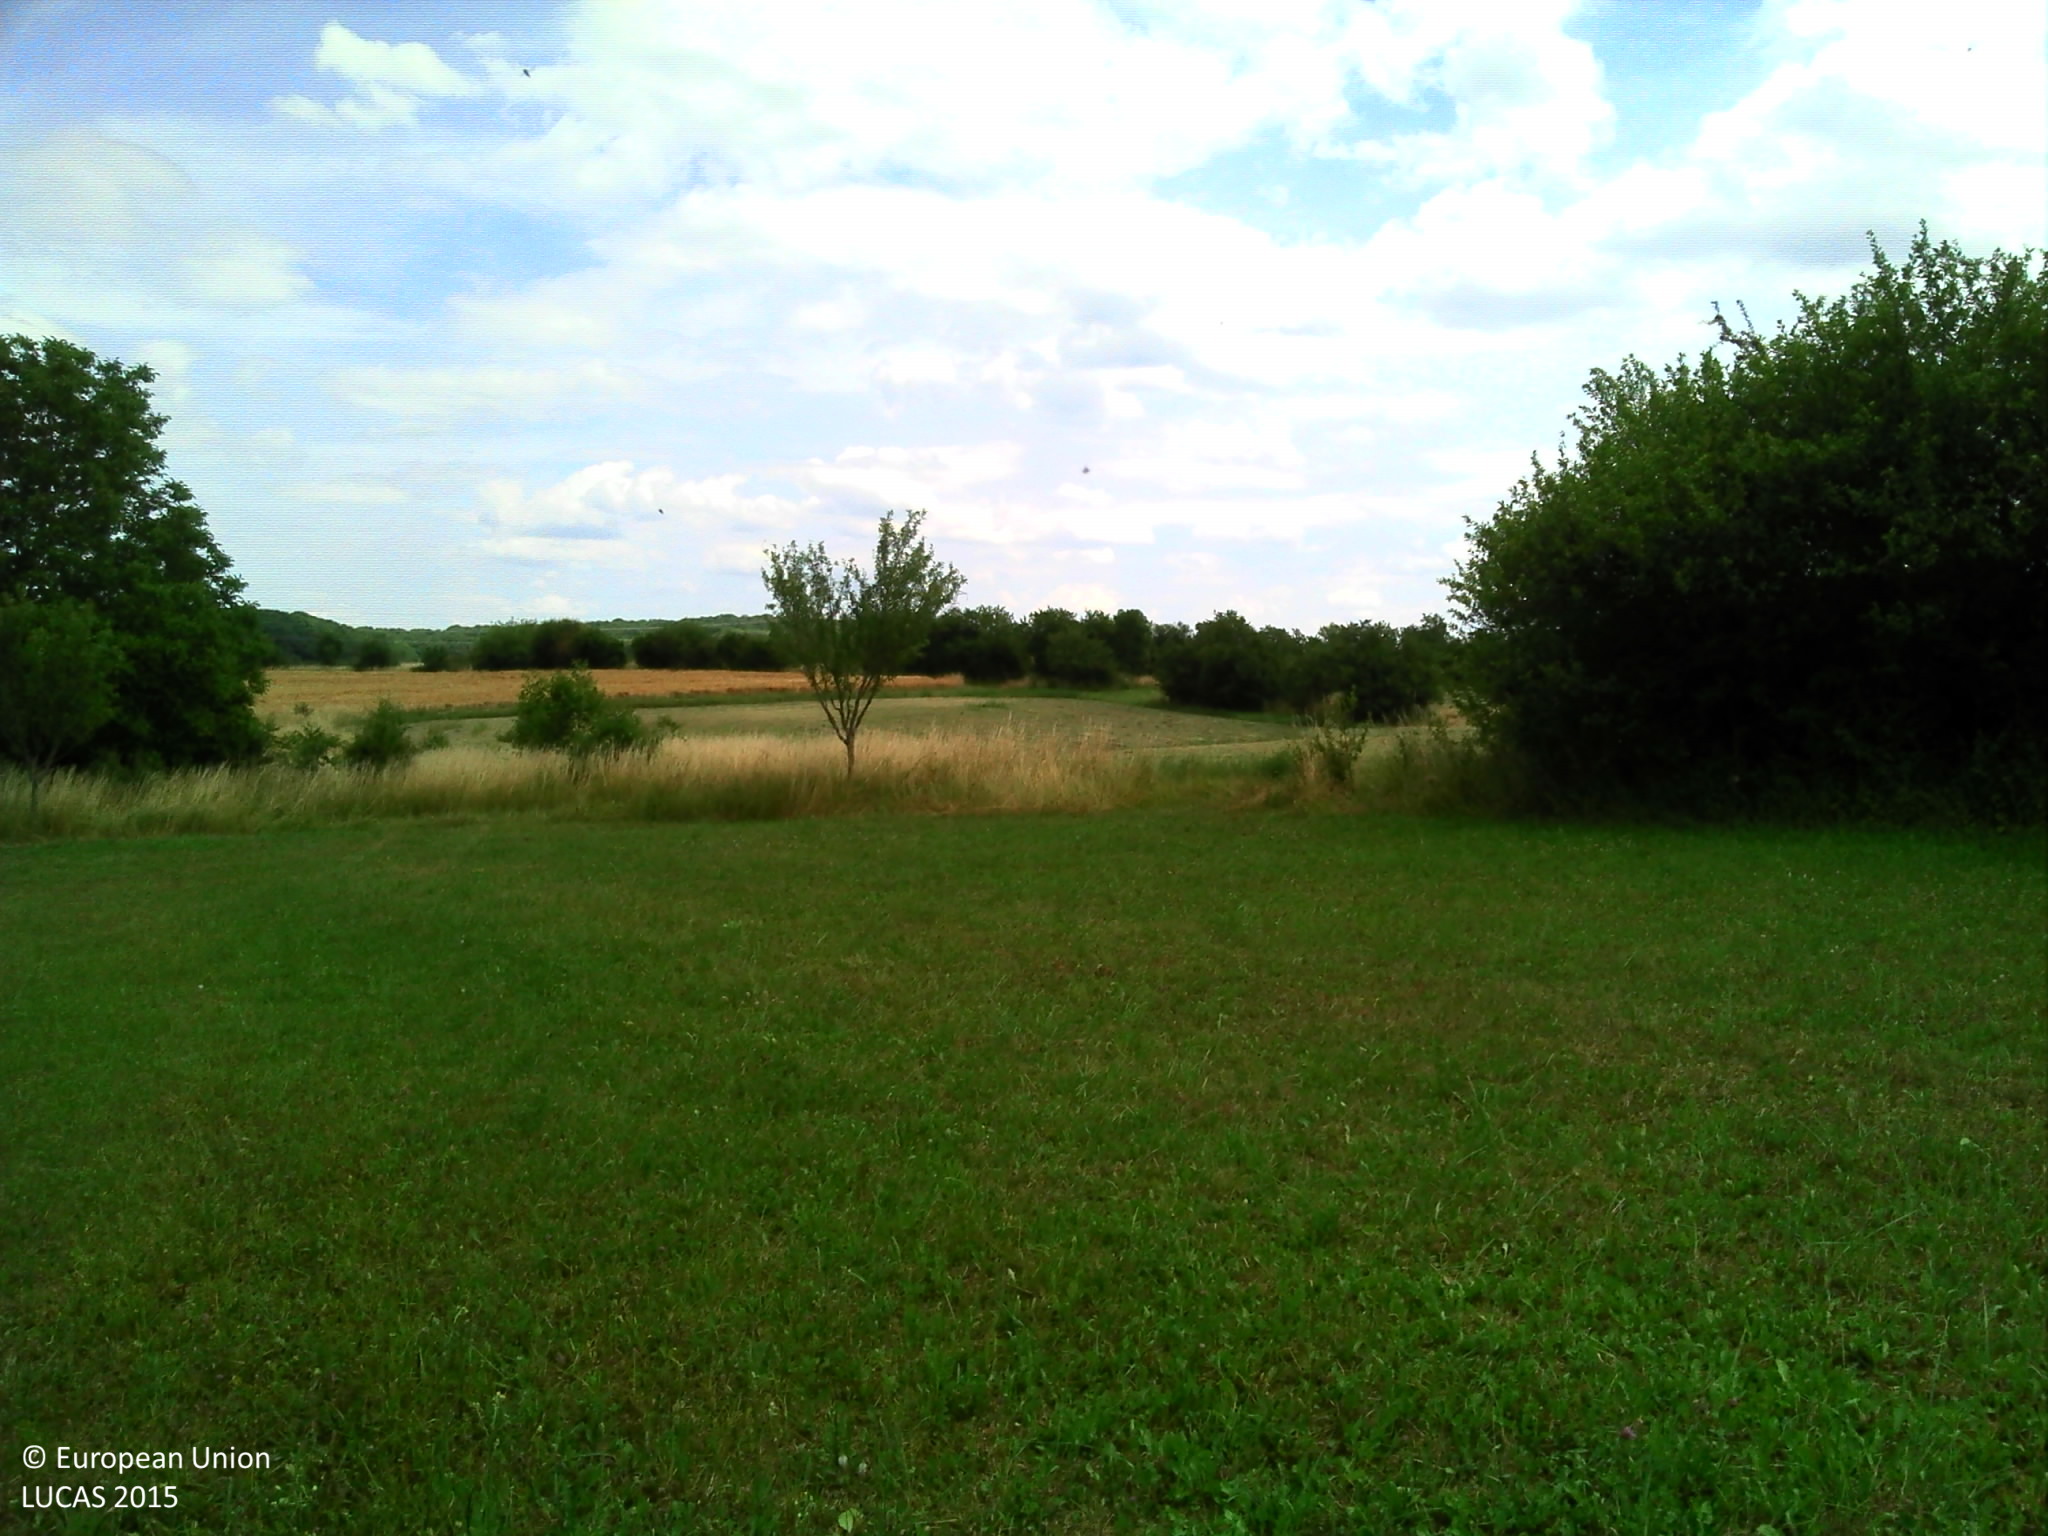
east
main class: Grassland
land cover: Grassland without tree/shrub cover
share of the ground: > 75 %
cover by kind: herbaceous plants 95 %, lichens and mosses 5 %
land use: Agriculture (excluding fallow land and kitchen gardens)
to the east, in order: Grassland without tree/shrub cover; Lines of trees; Grass margins; Tracks; Grass margins; Grassland without tree/shrub cover; Shrubland with sparse tree cover; Ditches and canals; Grass margins; Tracks; Grass margins; Lines of trees; Grassland without tree/shrub cover; Abandoned hedges; Fences; Grass margins; Maize
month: June
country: FR
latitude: 48.4275
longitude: 6.1757
